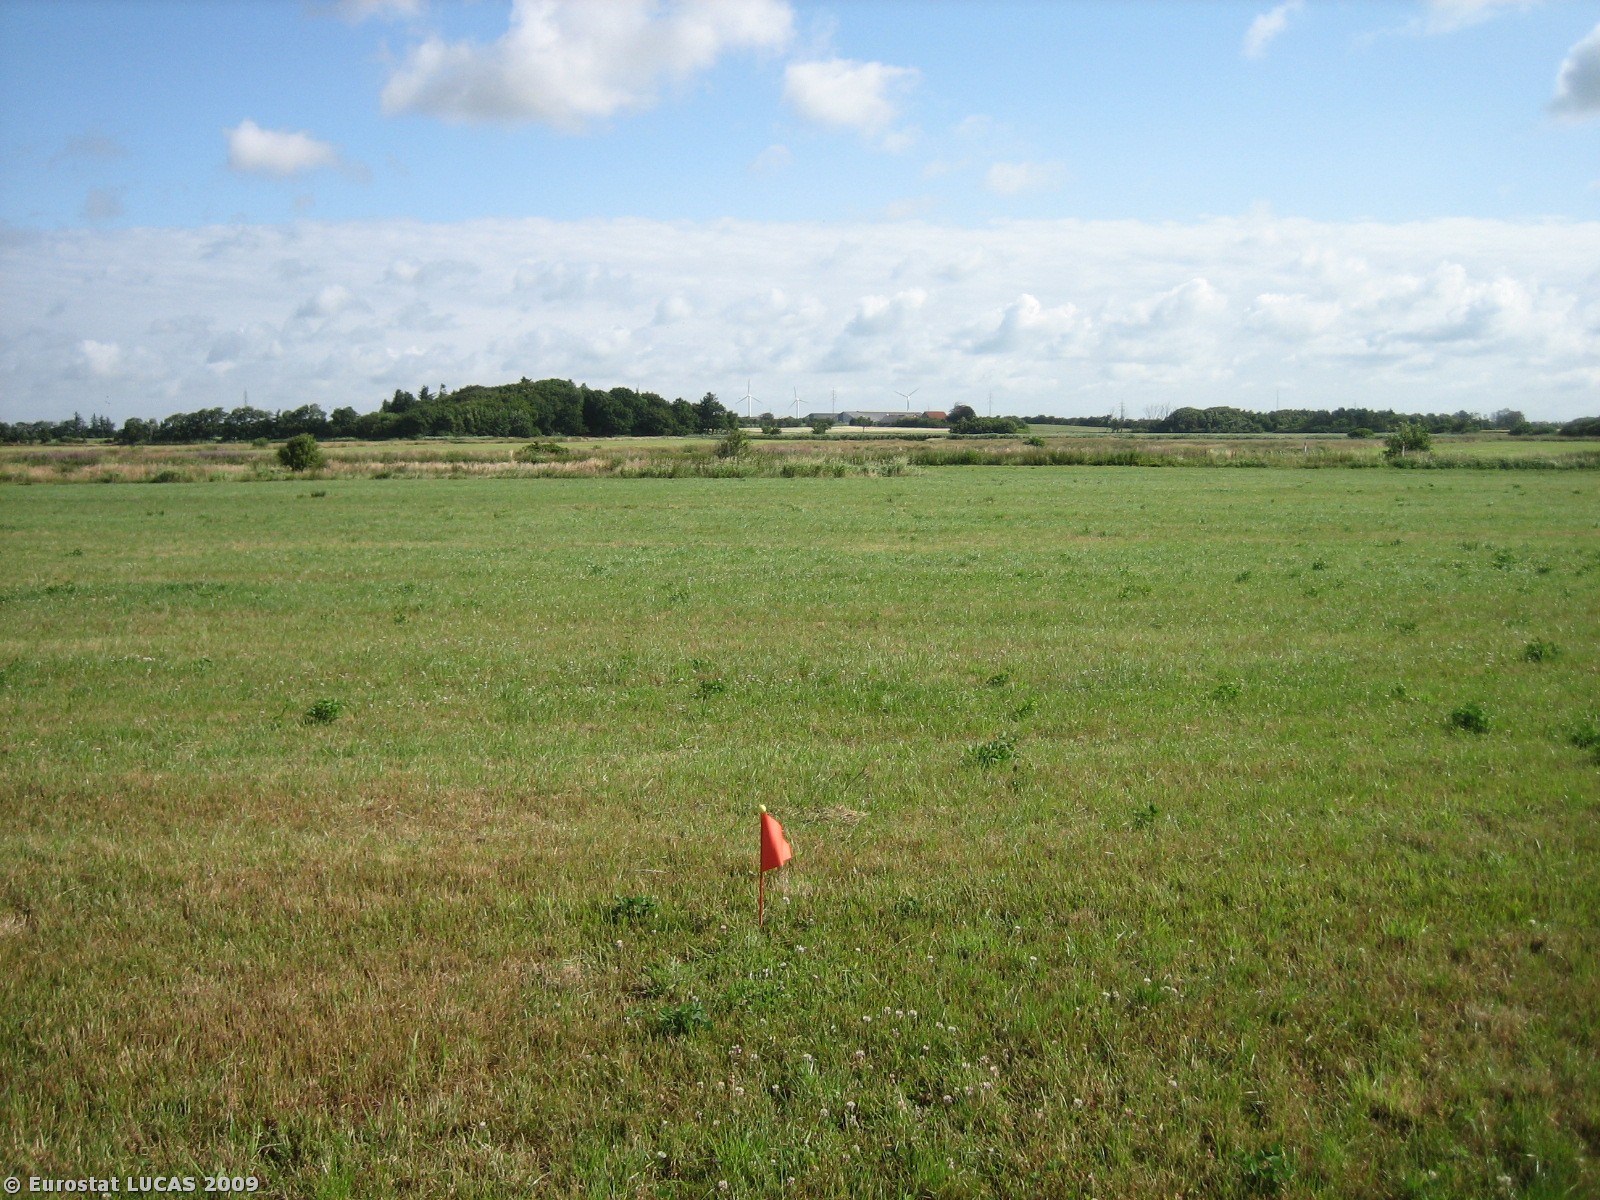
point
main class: Grassland
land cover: Grassland without tree/shrub cover
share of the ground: > 75 %
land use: Agriculture (excluding fallow land and kitchen gardens)
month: July
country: DK
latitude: 55.7270
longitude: 8.2979
